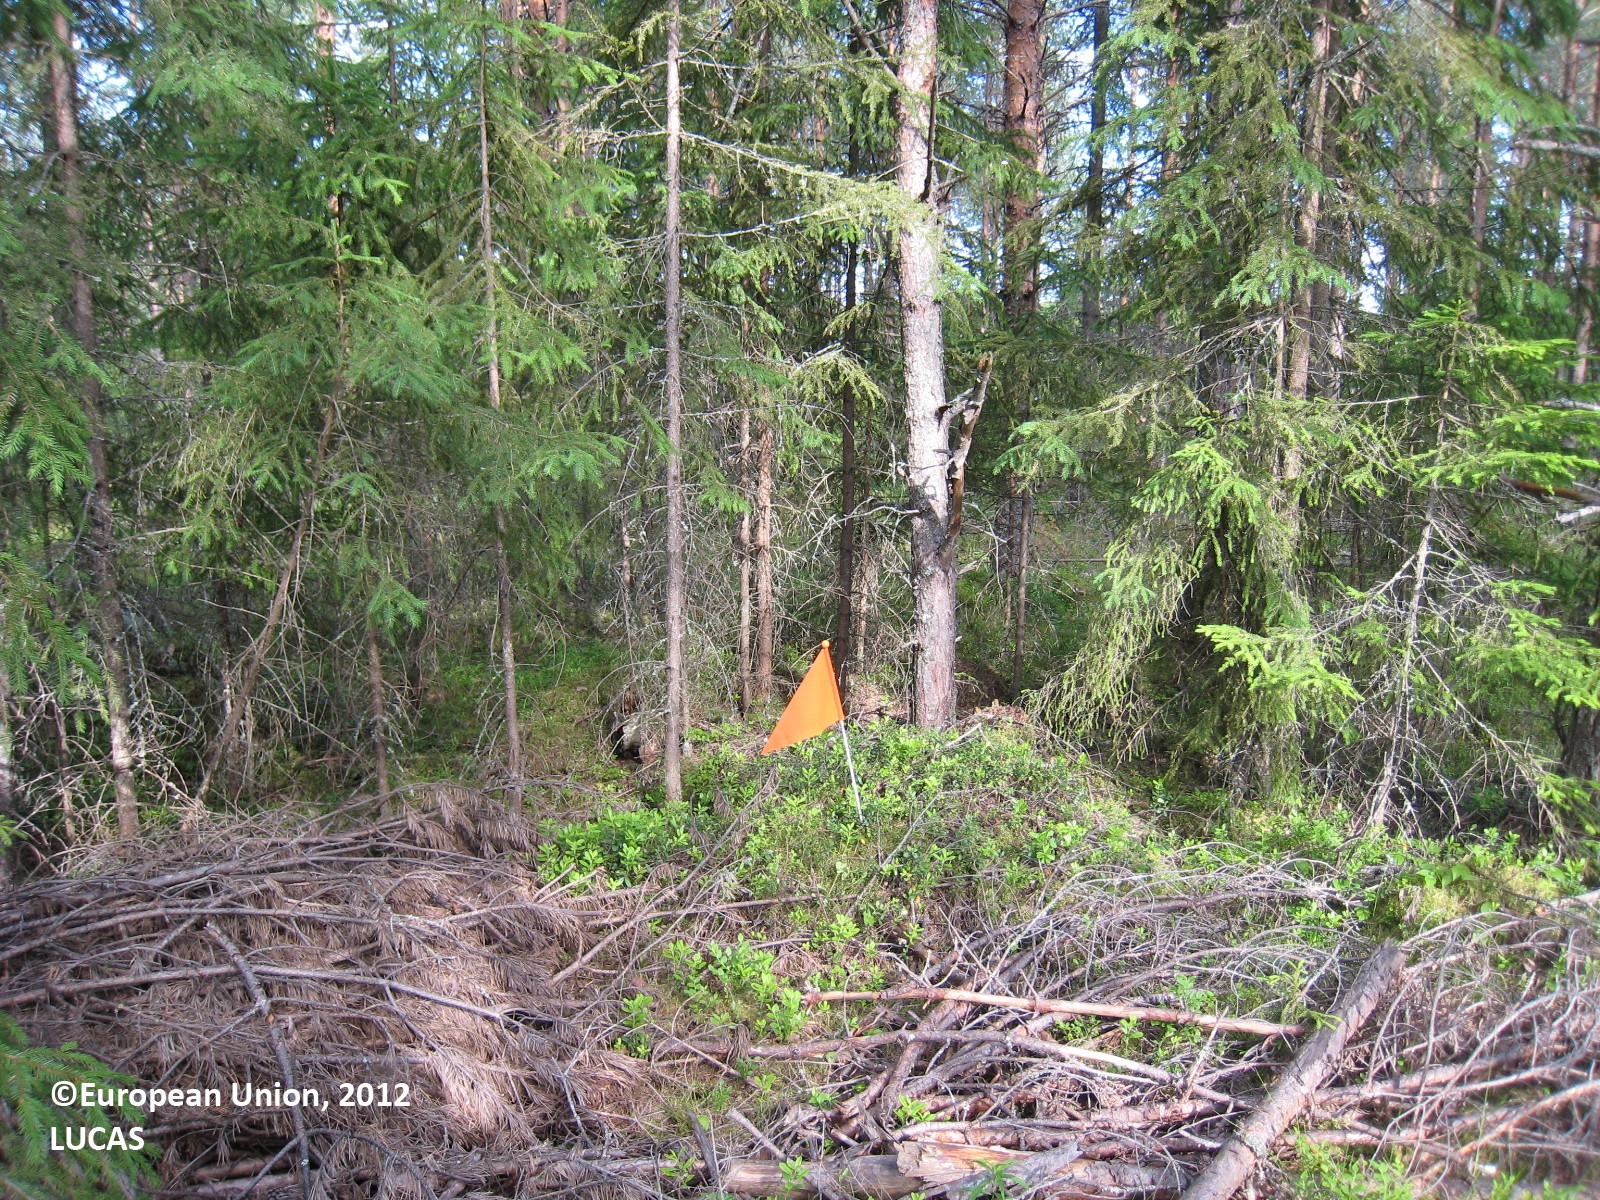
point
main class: Woodland
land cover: Other coniferous woodland
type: boreal forest
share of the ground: 50 - 75 %
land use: Forestry
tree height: > 5 m
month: July
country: FI
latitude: 62.7786
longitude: 25.6920
